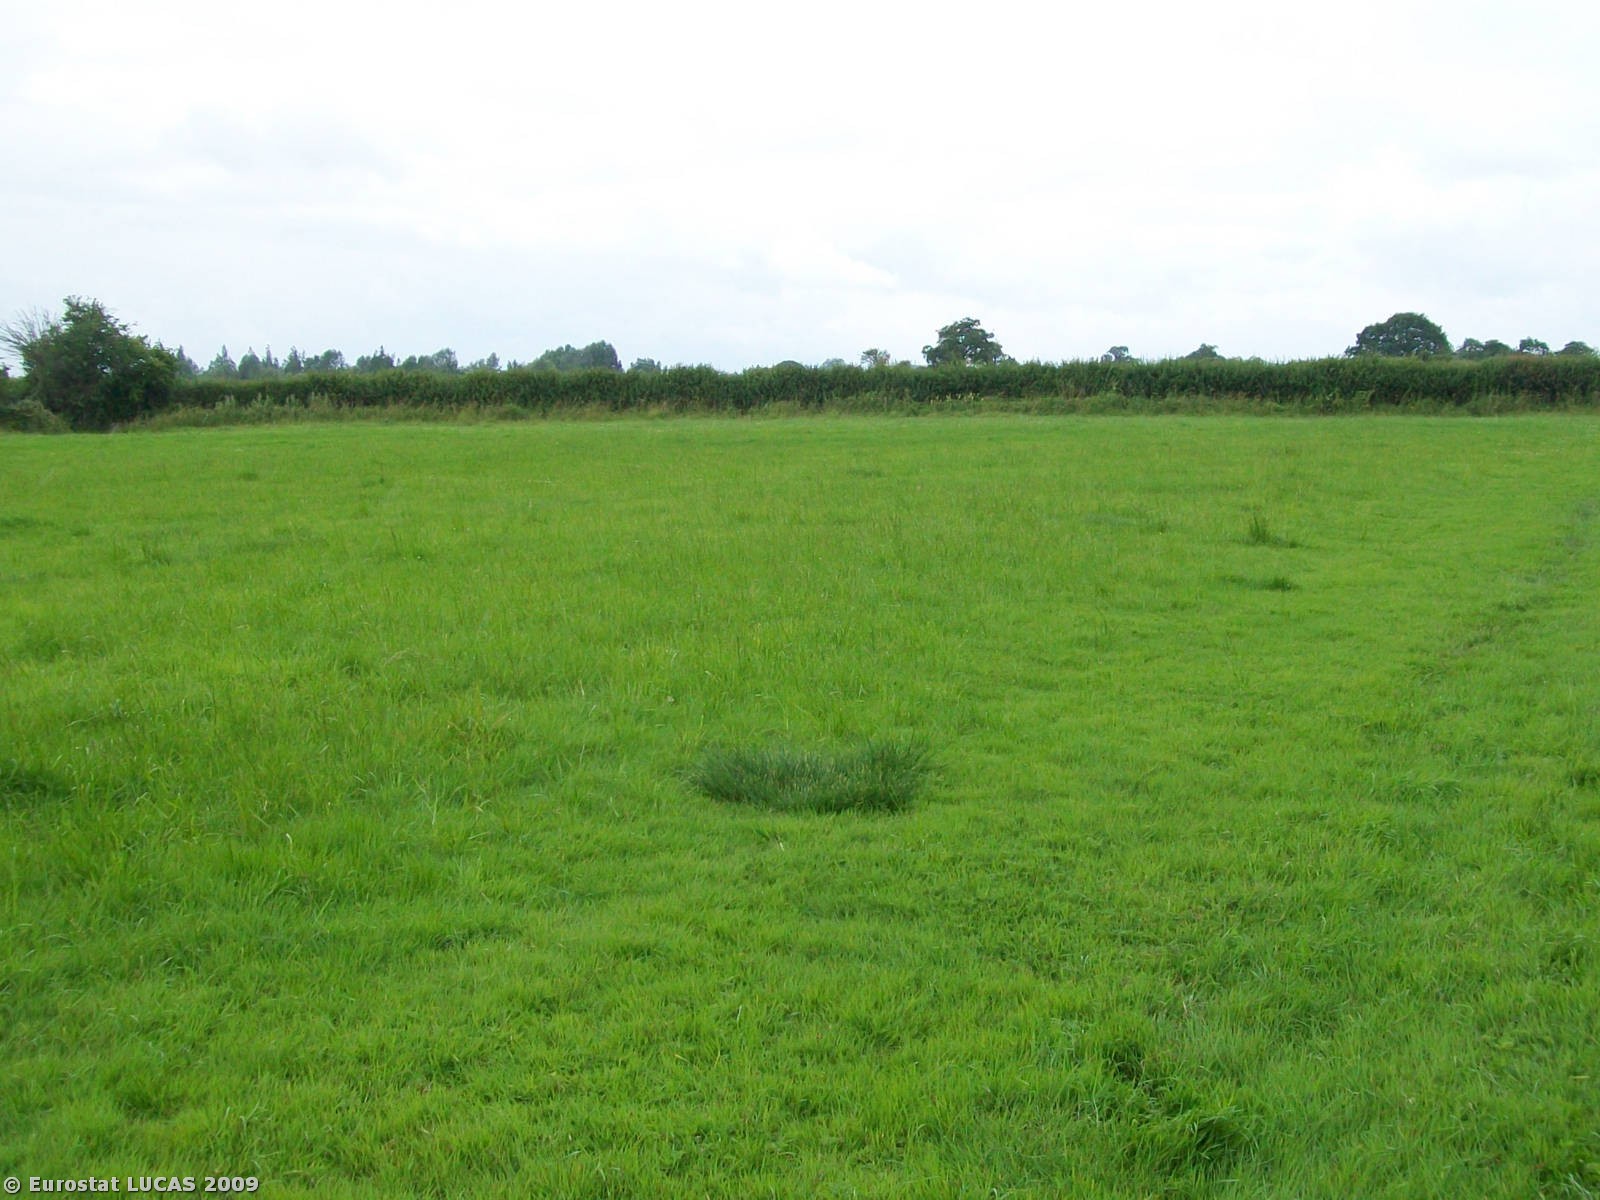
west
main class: Grassland
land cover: Grassland without tree/shrub cover
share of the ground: > 75 %
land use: Agriculture (excluding fallow land and kitchen gardens)
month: July
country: GB
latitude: 51.0072
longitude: -2.7983
